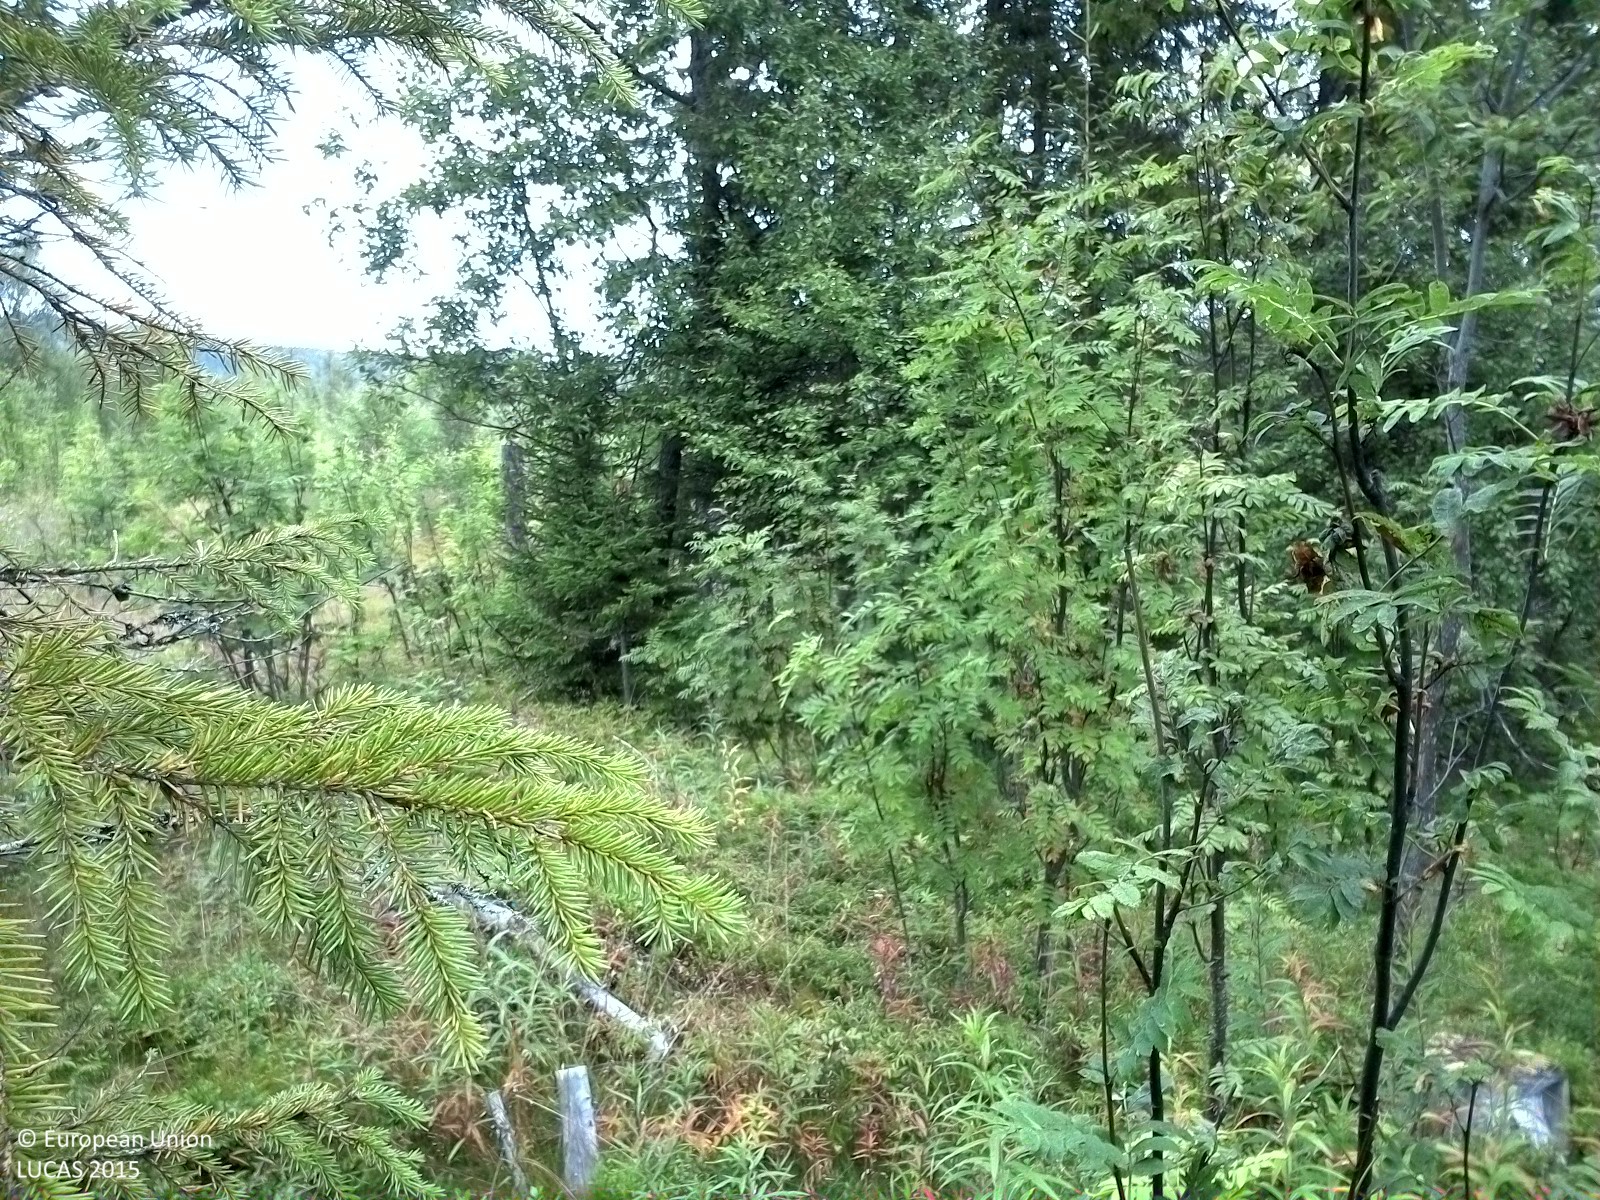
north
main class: Woodland
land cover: Spruce dominated mixed woodland
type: boreal forest
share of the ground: 25 - 50 %
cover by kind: herbaceous plants 30 %, coniferous forest trees 25 %, broadleaved forest trees 25 %, shrubs 20 %
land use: Forestry
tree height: > 5 m
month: August
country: SE
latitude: 62.2839
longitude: 16.2441
